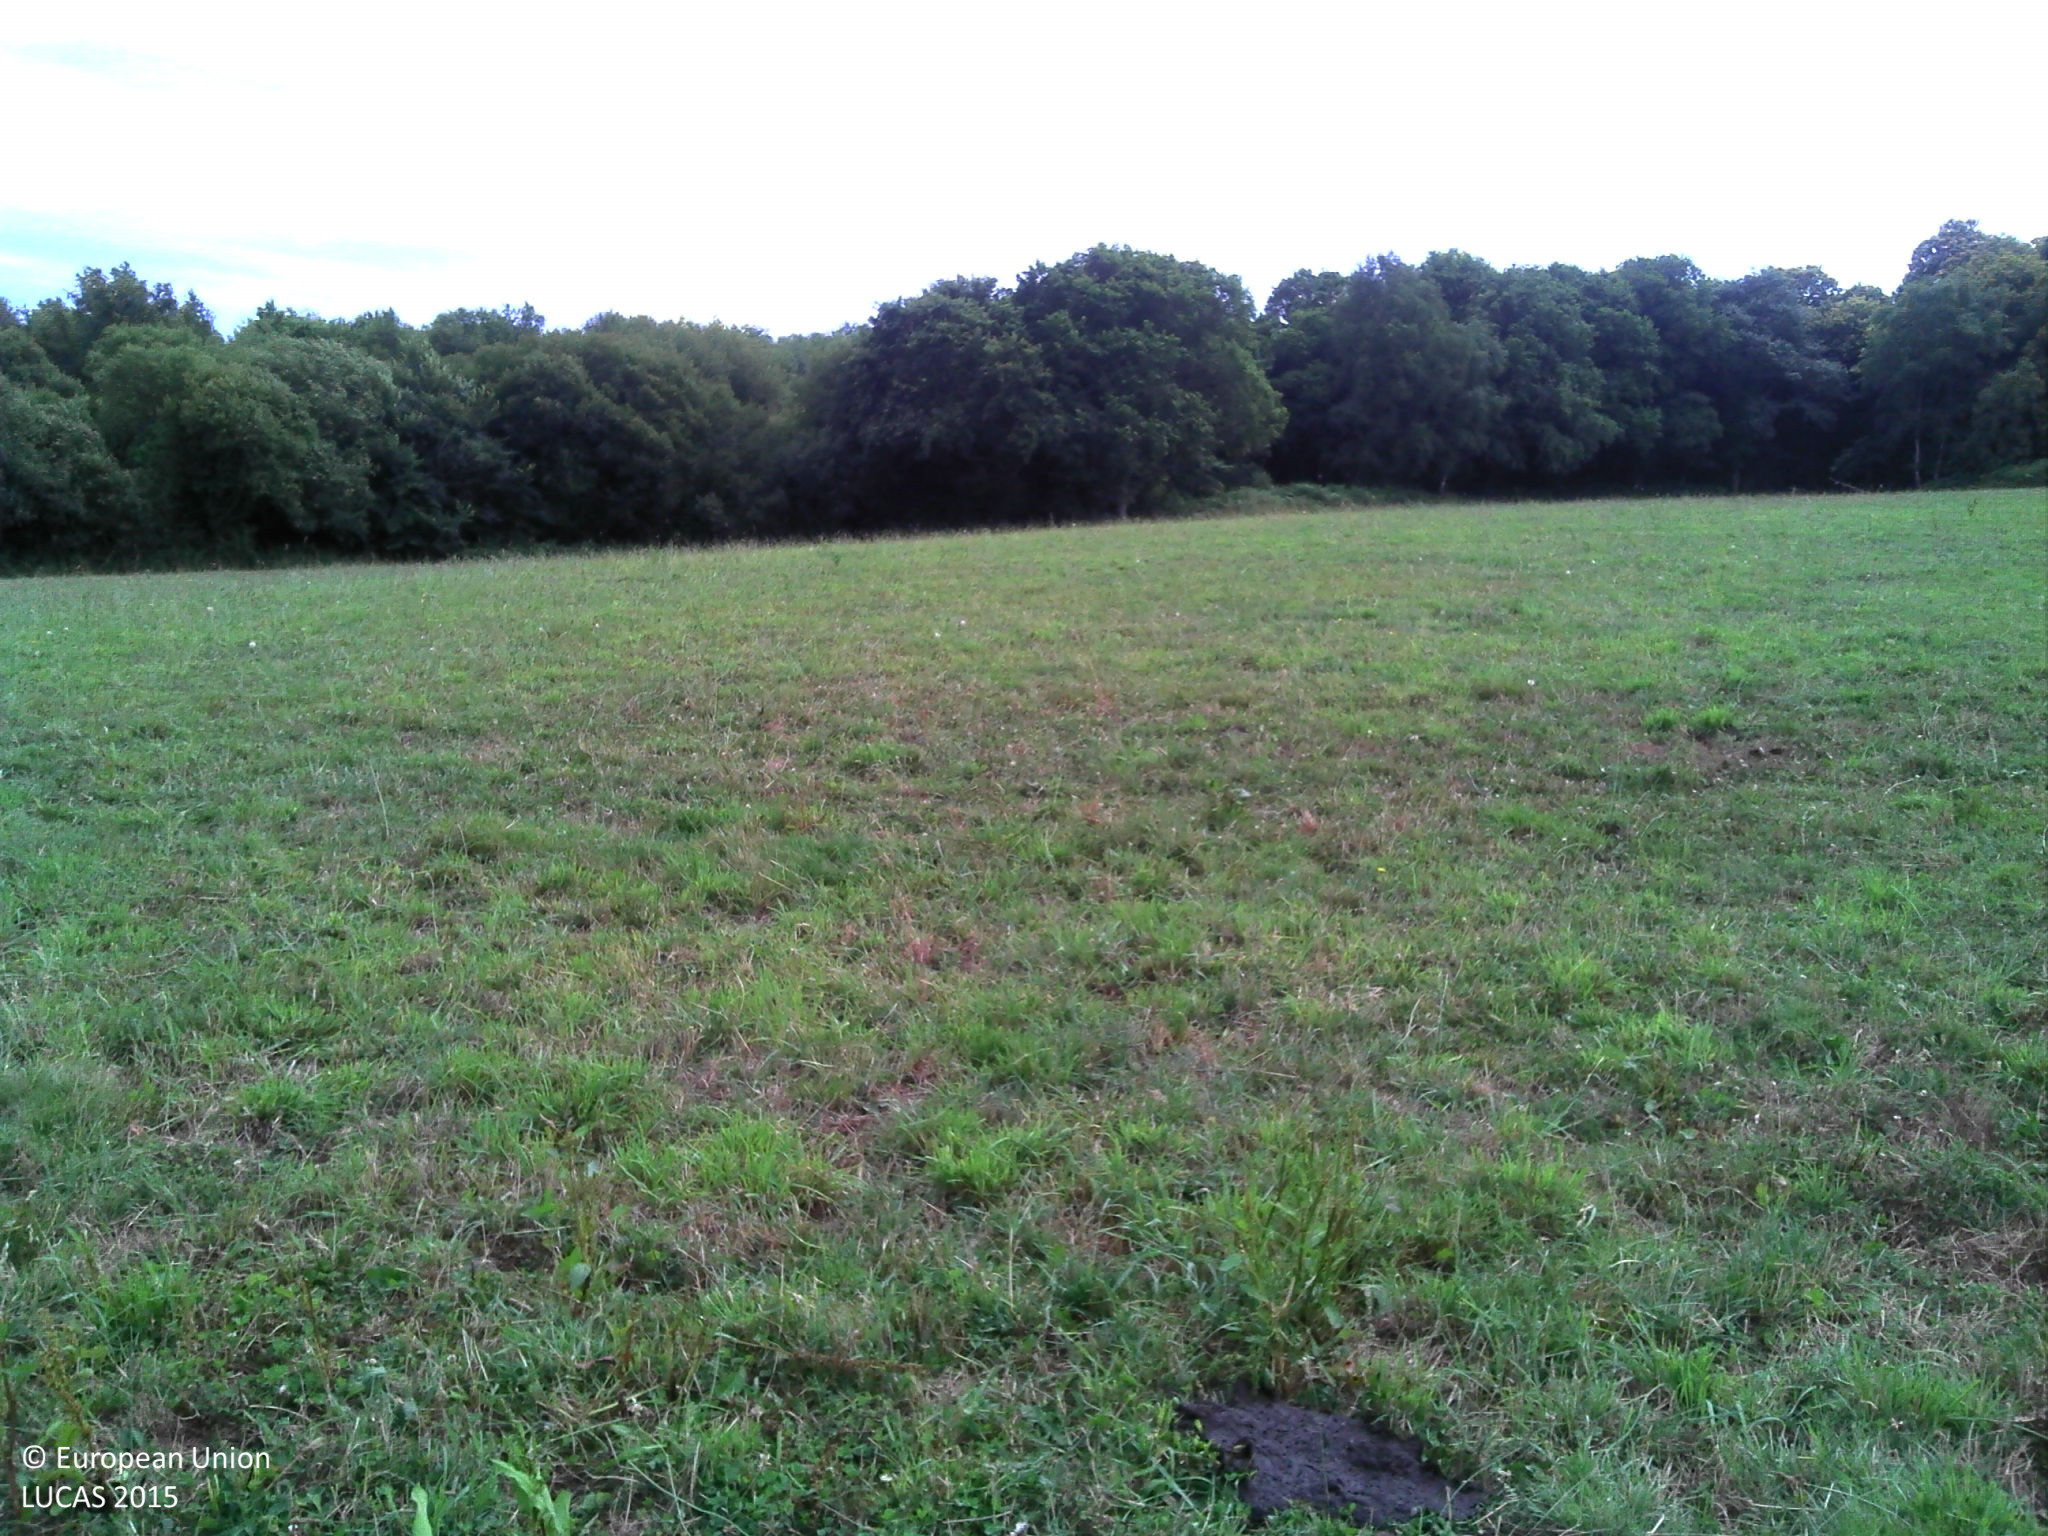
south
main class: Grassland
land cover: Grassland without tree/shrub cover
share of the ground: > 75 %
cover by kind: herbaceous plants 80 %, consolidated bare surface 20 %
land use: Agriculture (excluding fallow land and kitchen gardens)
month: July
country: FR
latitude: 47.8085
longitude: -3.4957
